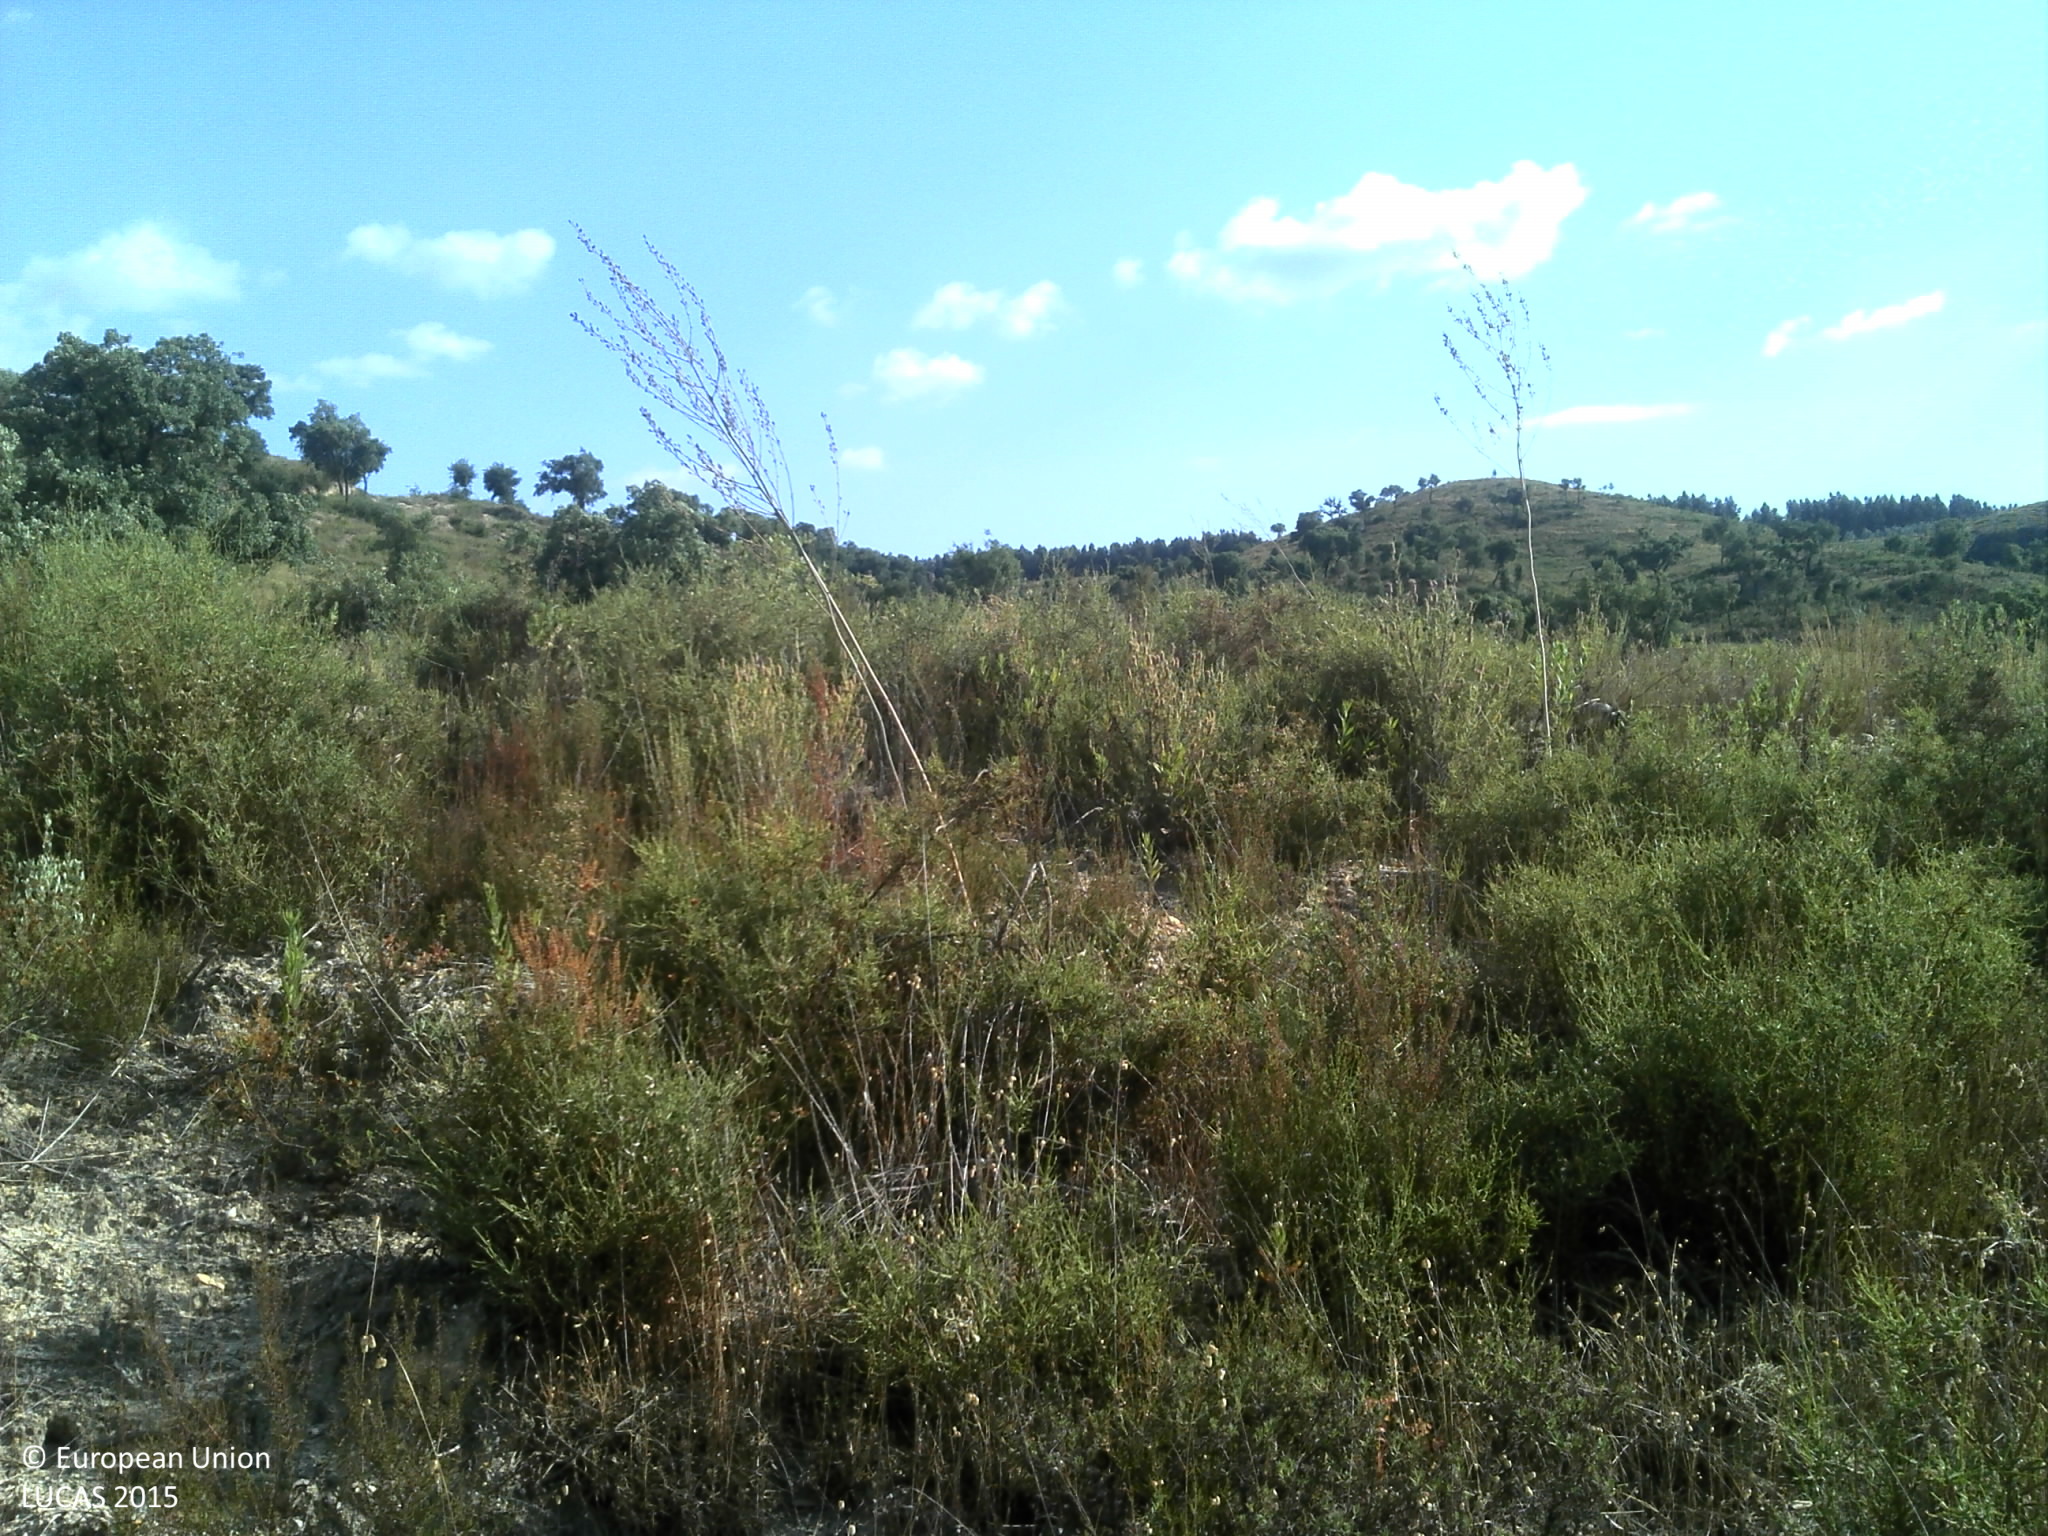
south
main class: Shrubland
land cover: Shrubland with sparse tree cover
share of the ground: 25 - 50 %
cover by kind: unconsolidated bare surface 65 %, shrubs 25 %, broadleaved forest trees 5 %, herbaceous plants 5 %
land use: Forestry
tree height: > 5 m
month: June
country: PT
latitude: 39.3011
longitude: -8.4231
